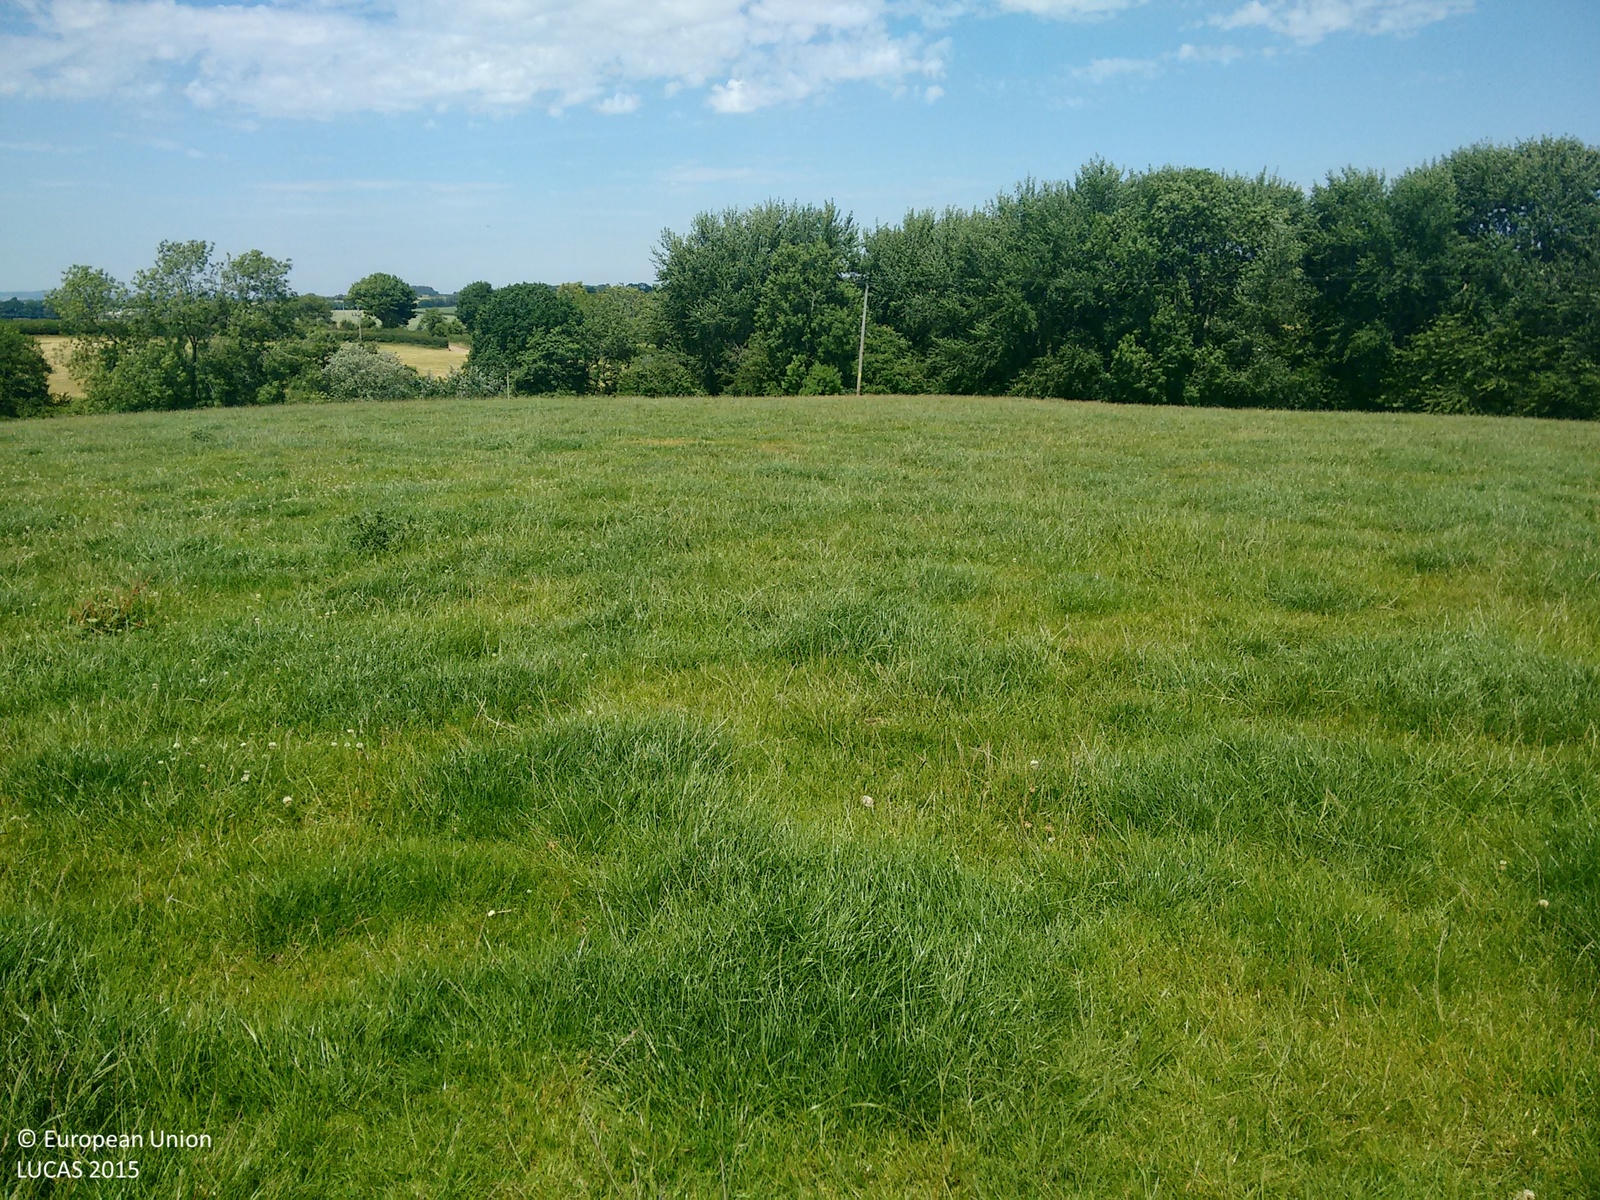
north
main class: Grassland
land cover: Grassland without tree/shrub cover
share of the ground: > 75 %
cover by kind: herbaceous plants 100 %
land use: Agriculture (excluding fallow land and kitchen gardens)
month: July
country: GB
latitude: 52.1906
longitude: -2.6342
